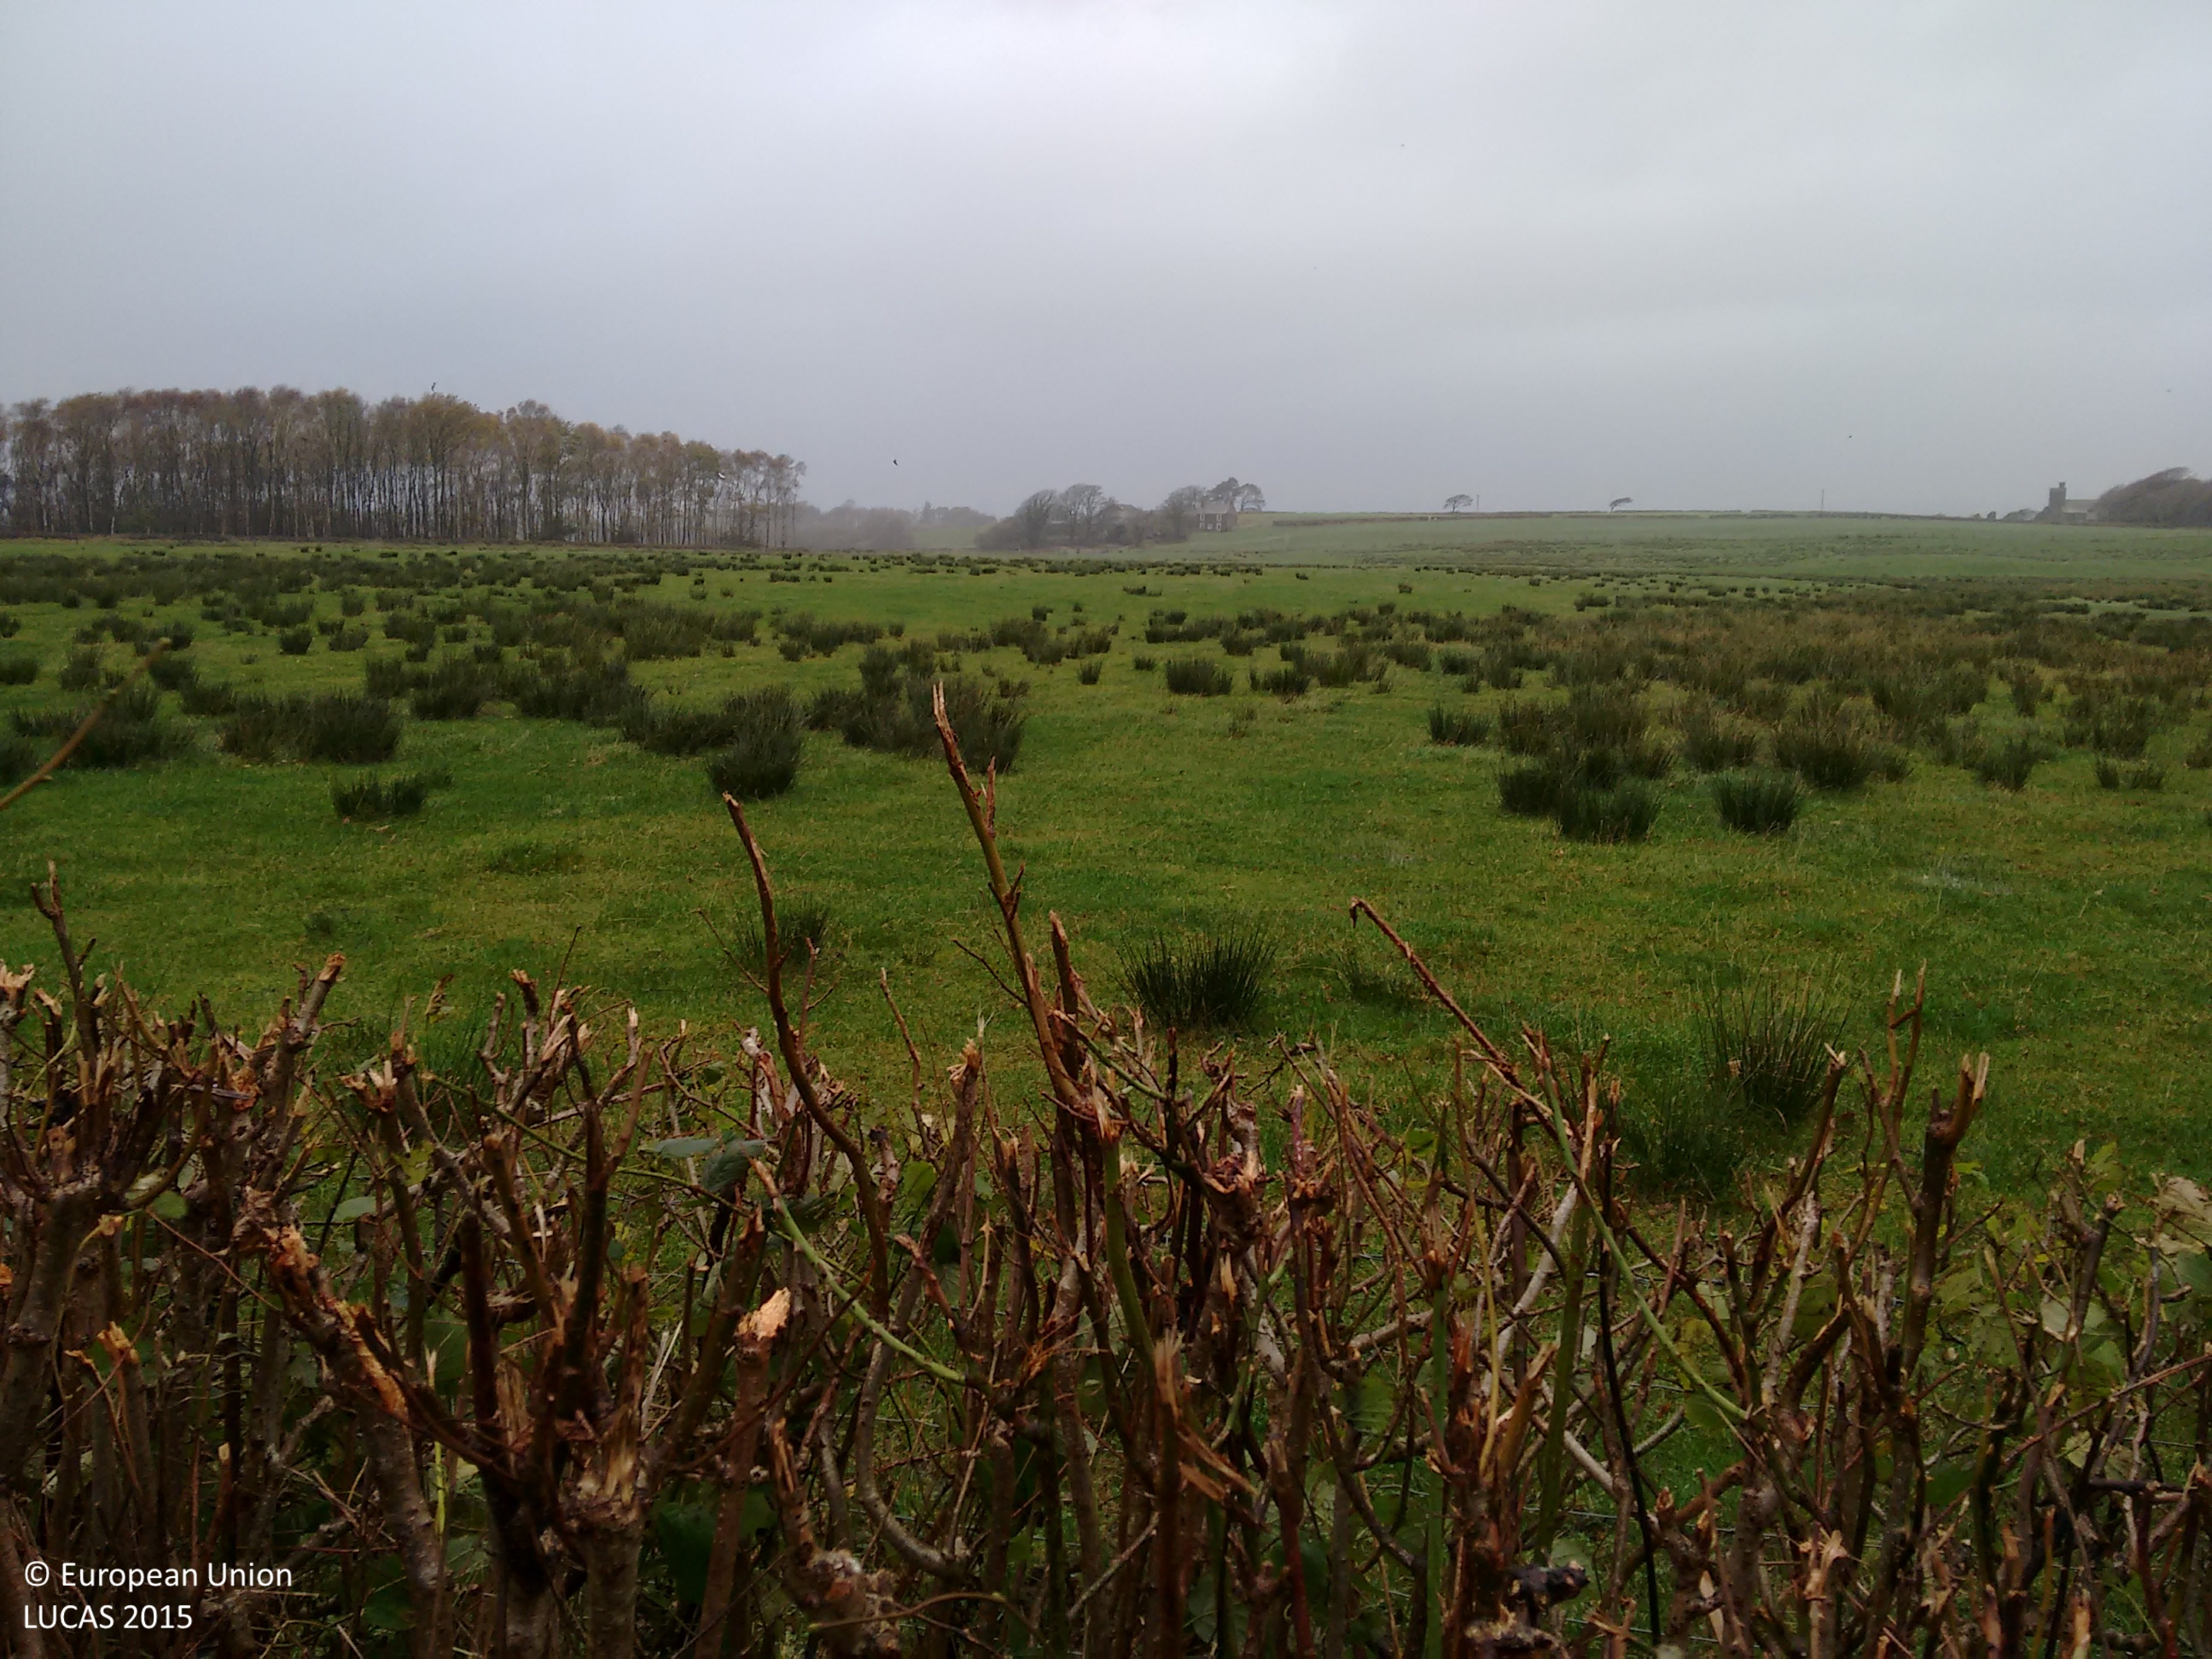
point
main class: Grassland
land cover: Grassland without tree/shrub cover
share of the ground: > 75 %
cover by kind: herbaceous plants 100 %
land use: Agriculture (excluding fallow land and kitchen gardens)
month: November
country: GB
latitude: 54.3857
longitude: -3.3998
